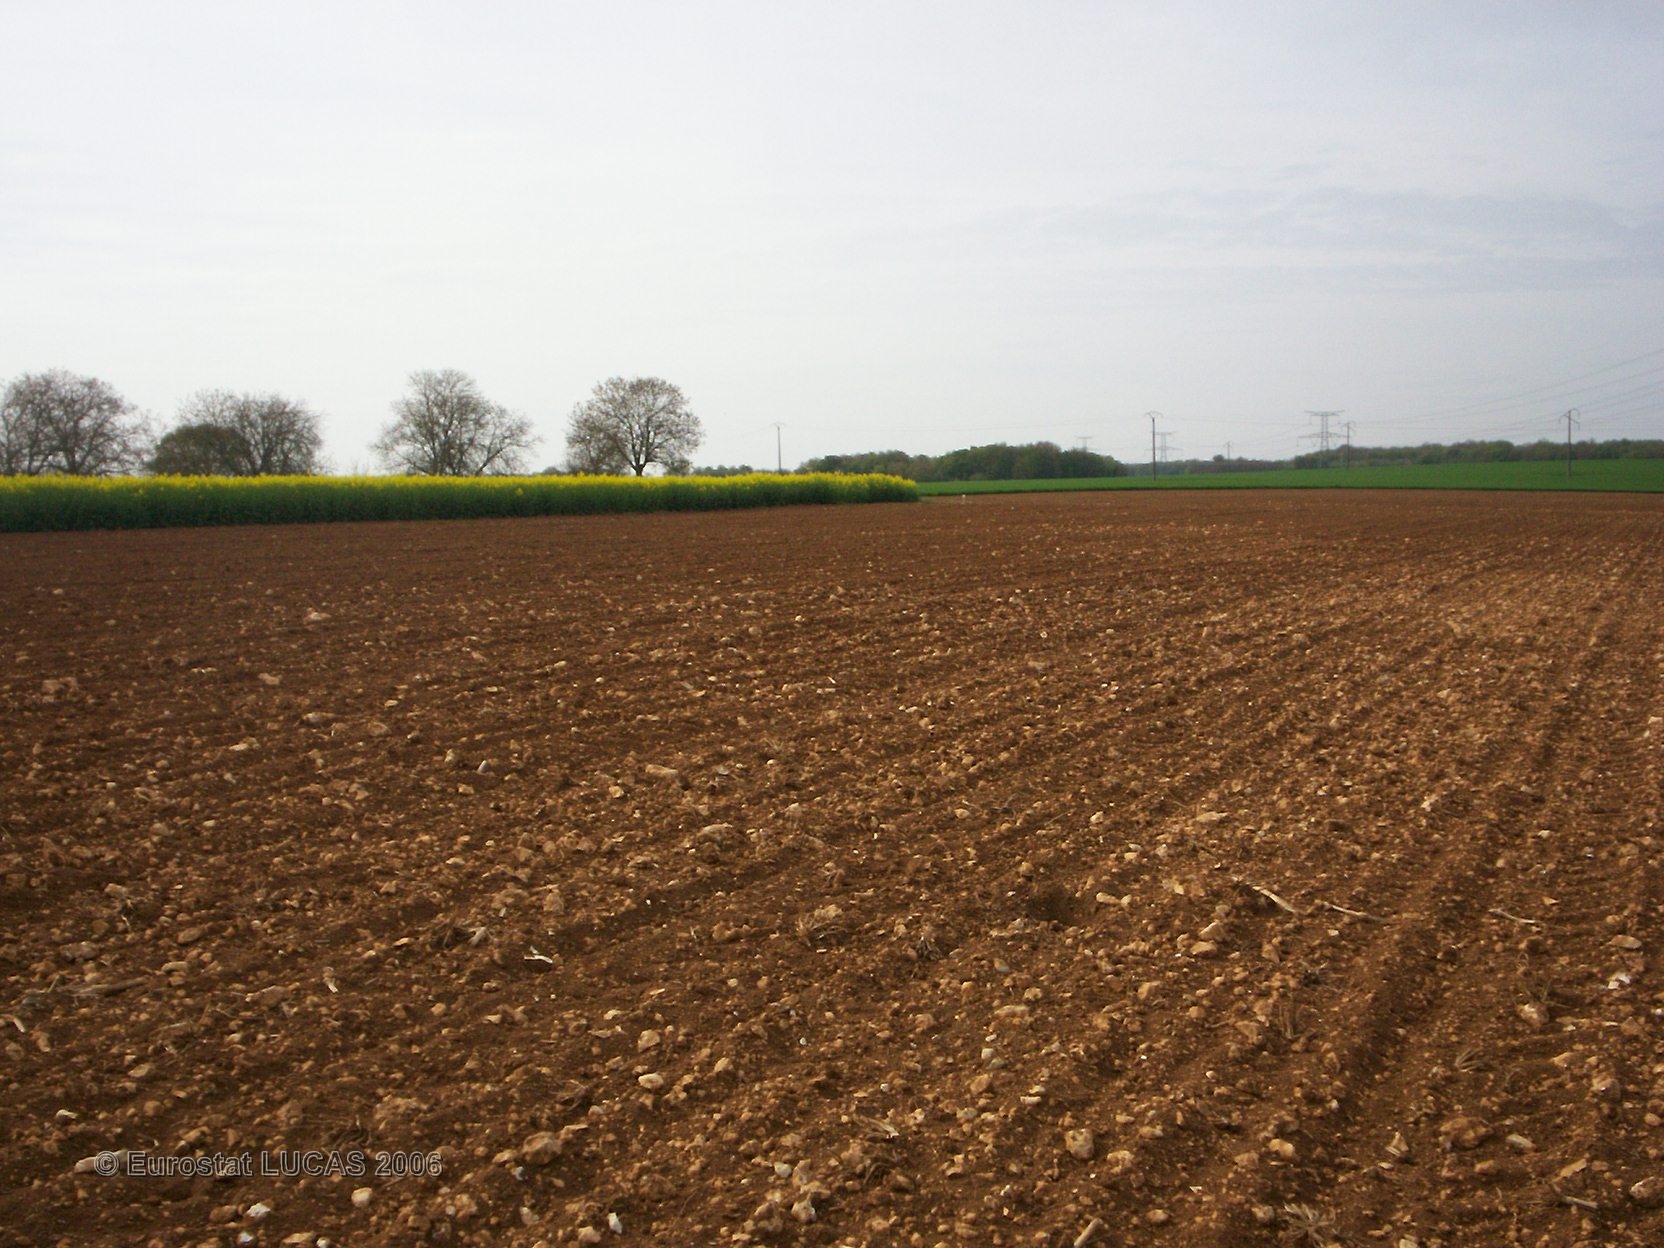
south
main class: Cropland
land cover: Sunflower
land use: Agriculture (excluding fallow land and kitchen gardens)
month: May
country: FR
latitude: 47.3160
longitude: 3.0231
